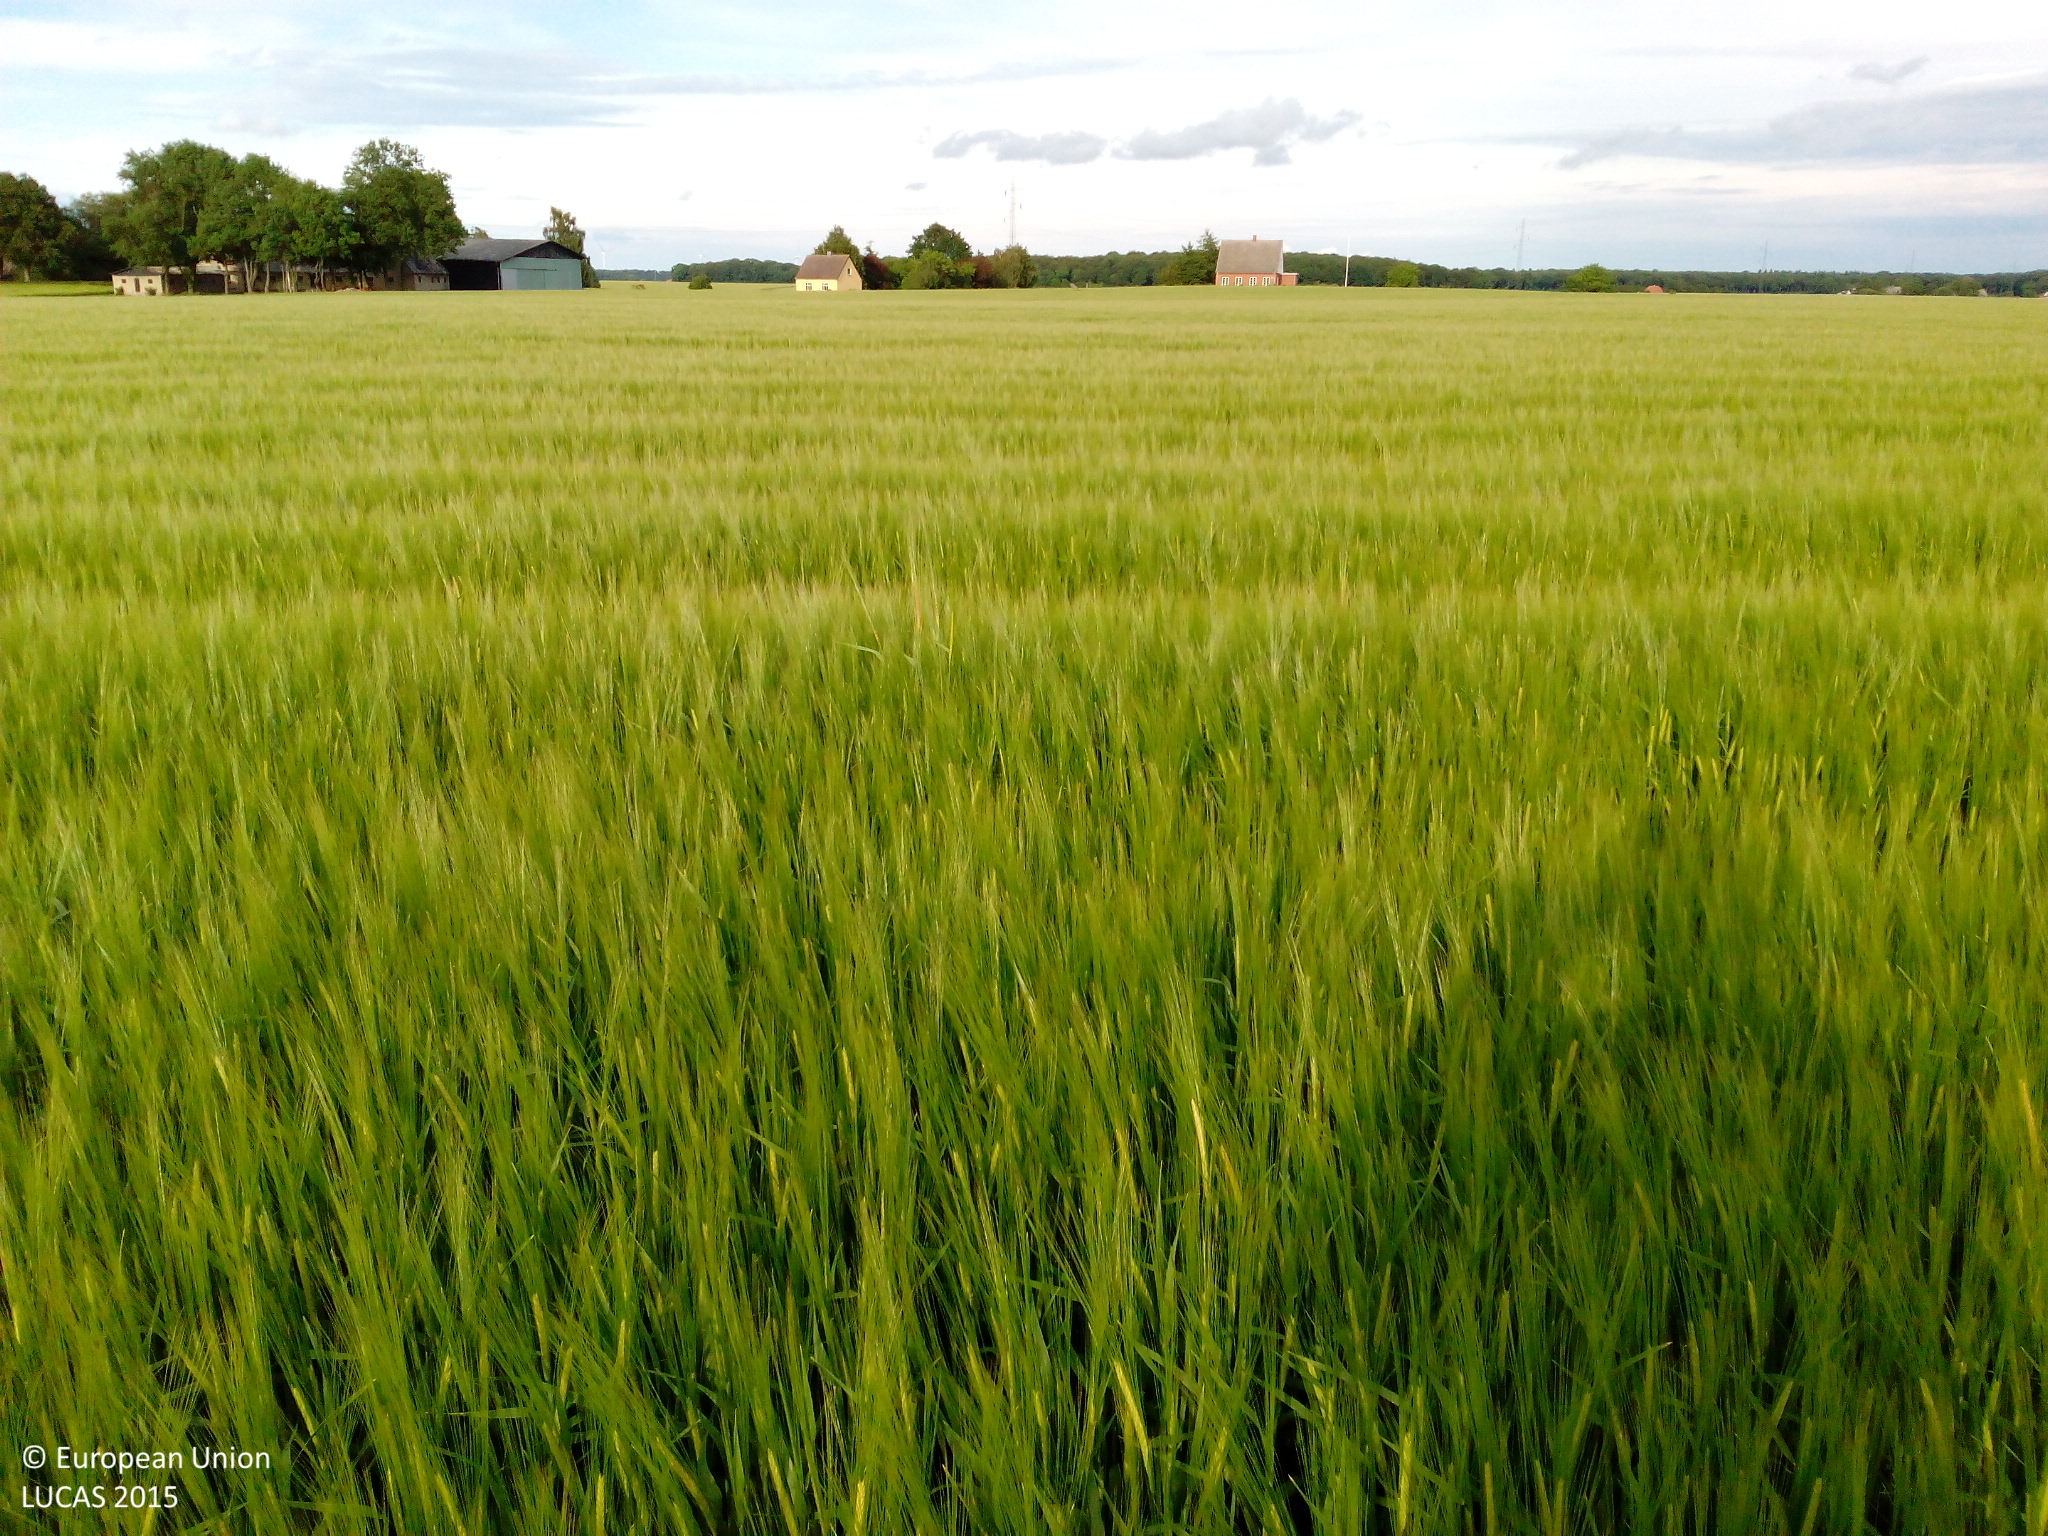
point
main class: Cropland
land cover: Barley
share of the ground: > 75 %
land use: Agriculture (excluding fallow land and kitchen gardens)
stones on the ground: < 10 %
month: June
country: DK
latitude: 54.7957
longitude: 11.4144
